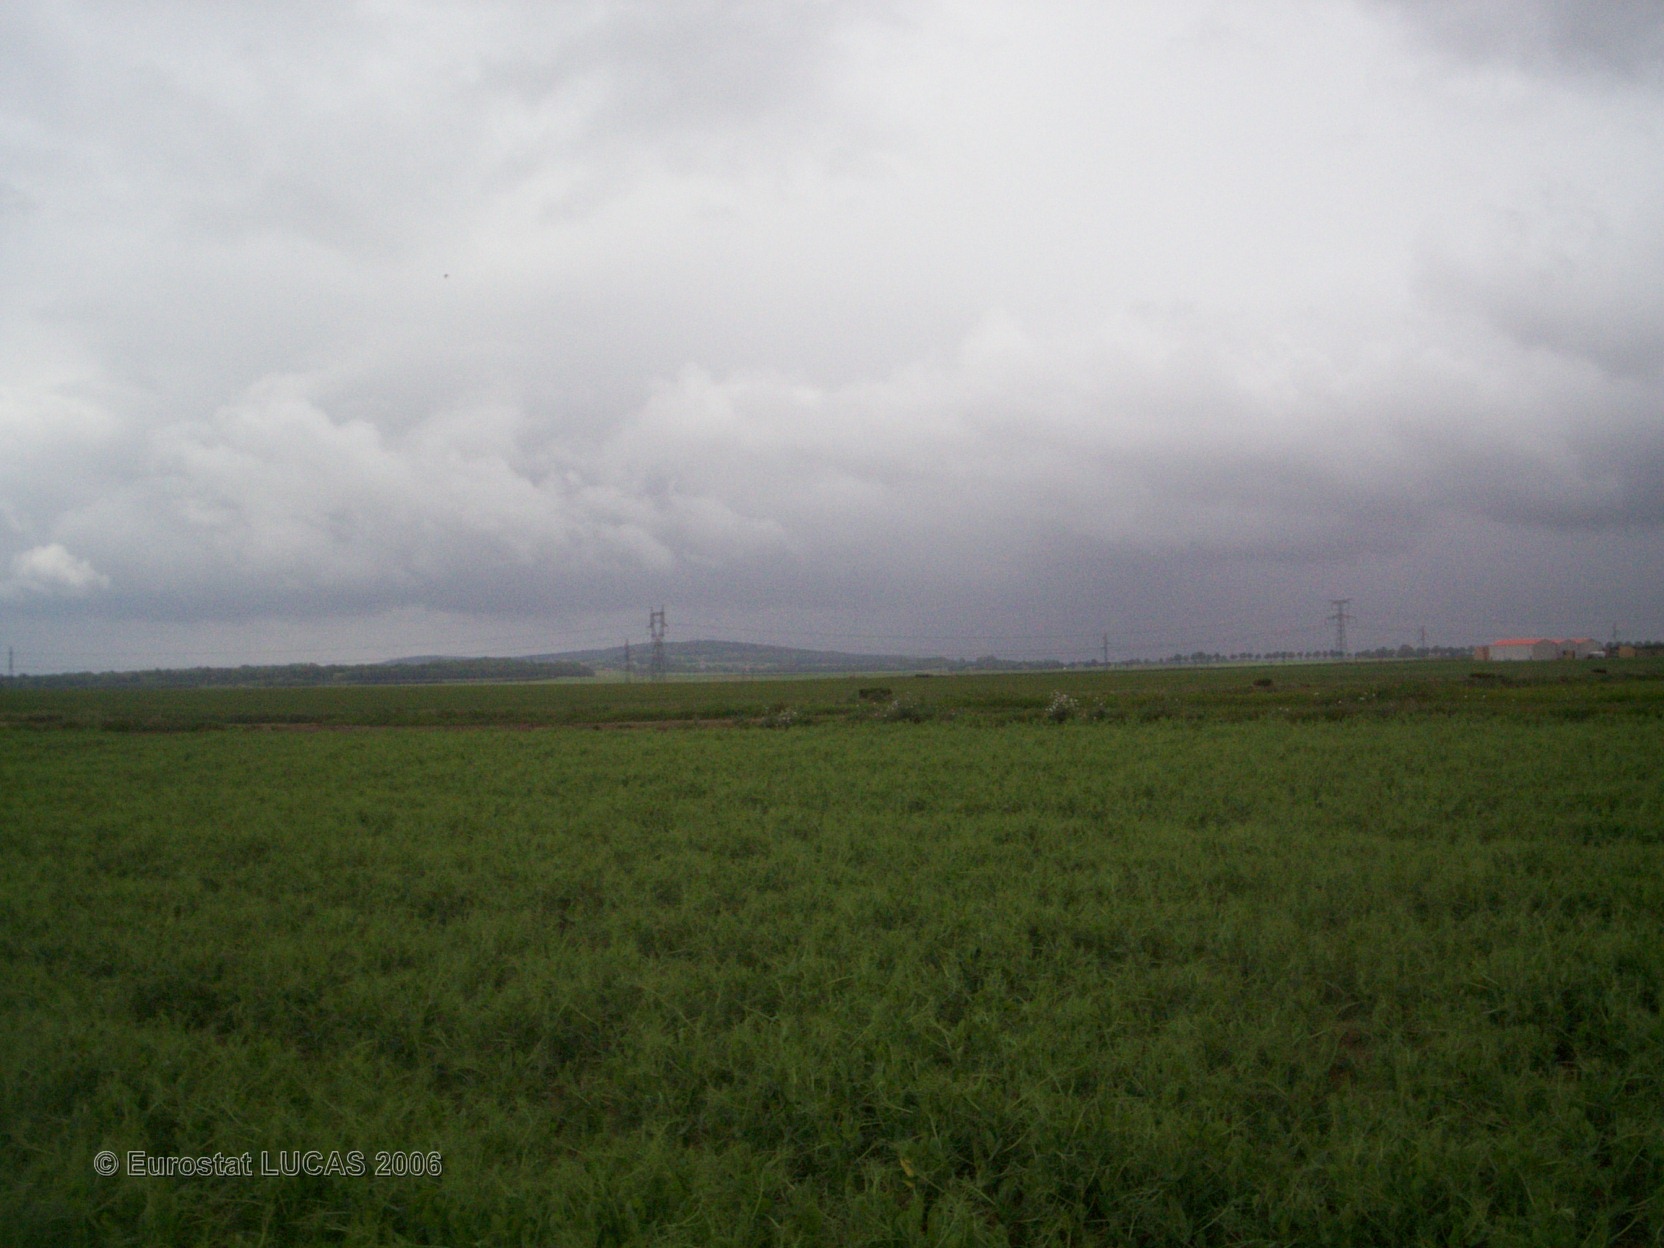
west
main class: Cropland
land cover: Dry pulses
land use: Agriculture (excluding fallow land and kitchen gardens)
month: May
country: FR
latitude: 49.2670
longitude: 2.7472
